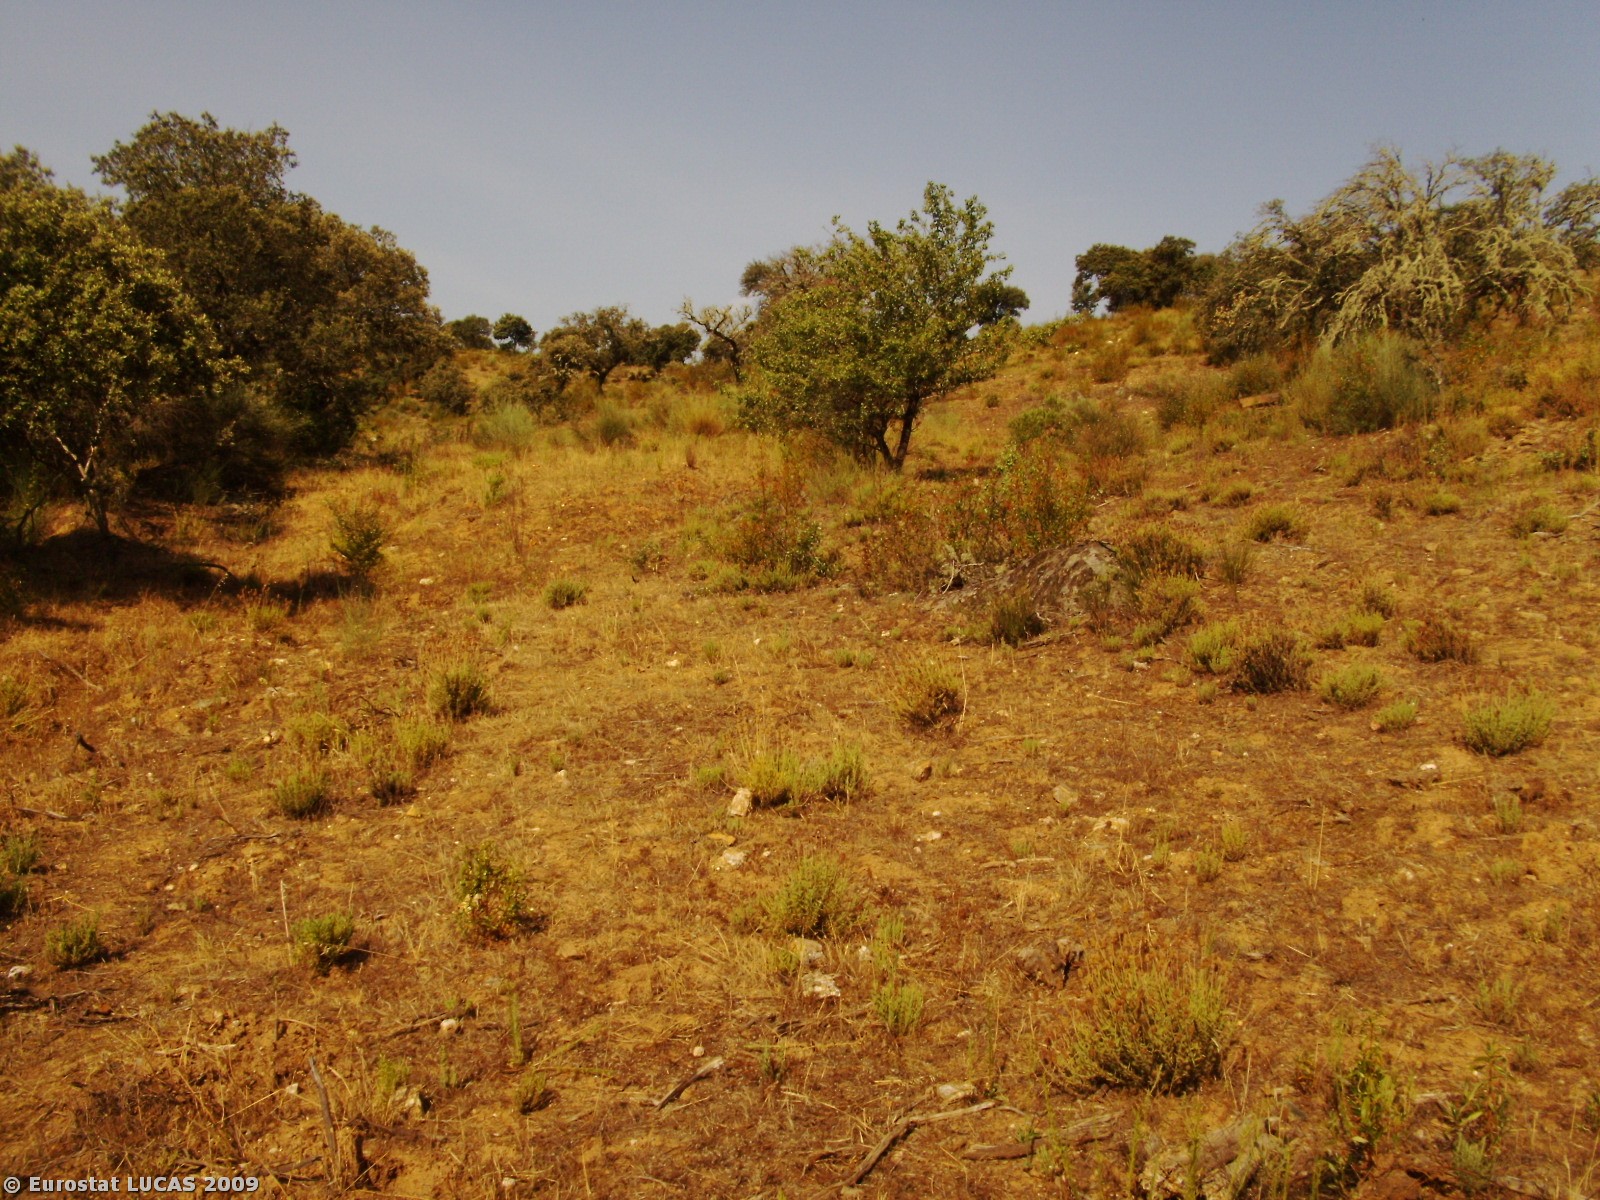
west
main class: Woodland
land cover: Broadleaved woodland
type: broadleaved evergreen forest
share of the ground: 50 - 75 %
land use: Forestry
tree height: > 5 m
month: June
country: PT
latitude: 39.9835
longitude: -7.1319
